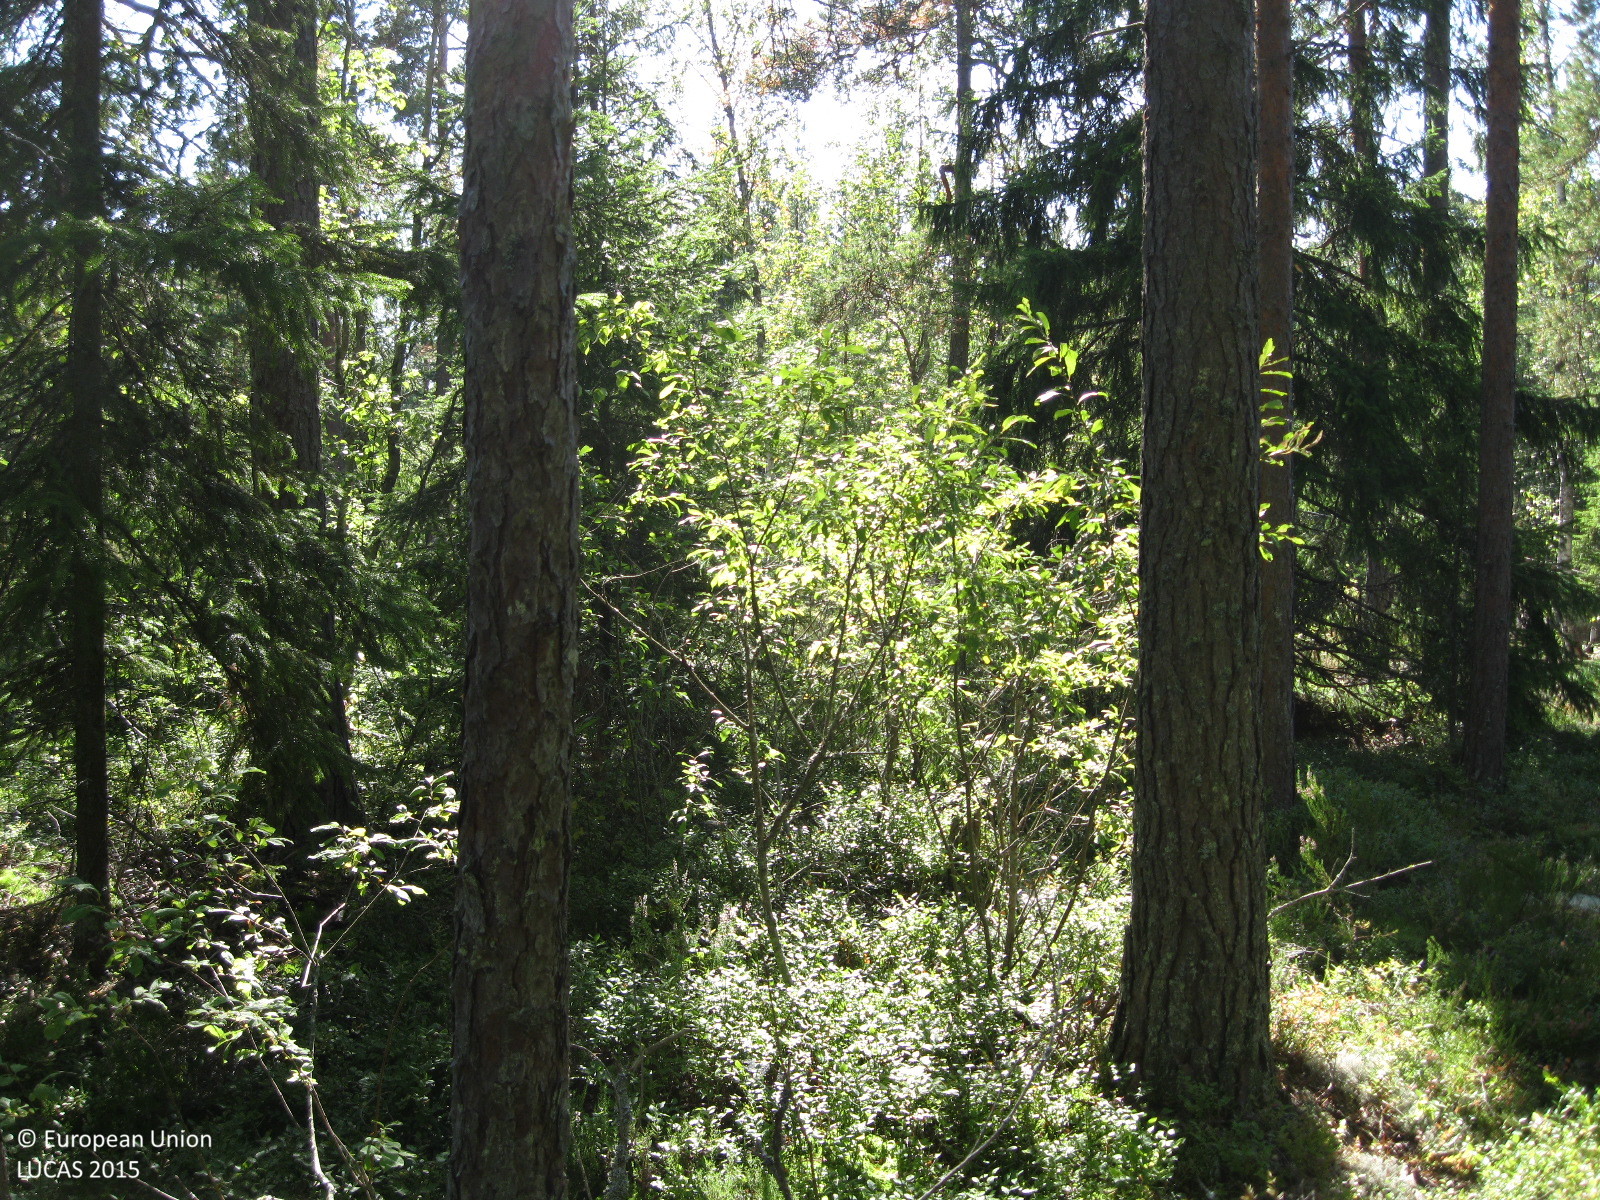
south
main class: Woodland
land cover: Pine dominated coniferous woodland
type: boreal forest
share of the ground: 50 - 75 %
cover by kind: coniferous forest trees 65 %, shrubs 15 %, herbaceous plants 15 %, broadleaved forest trees 5 %
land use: Forestry
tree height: > 5 m
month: September
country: FI
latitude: 60.6320
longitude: 24.9026
